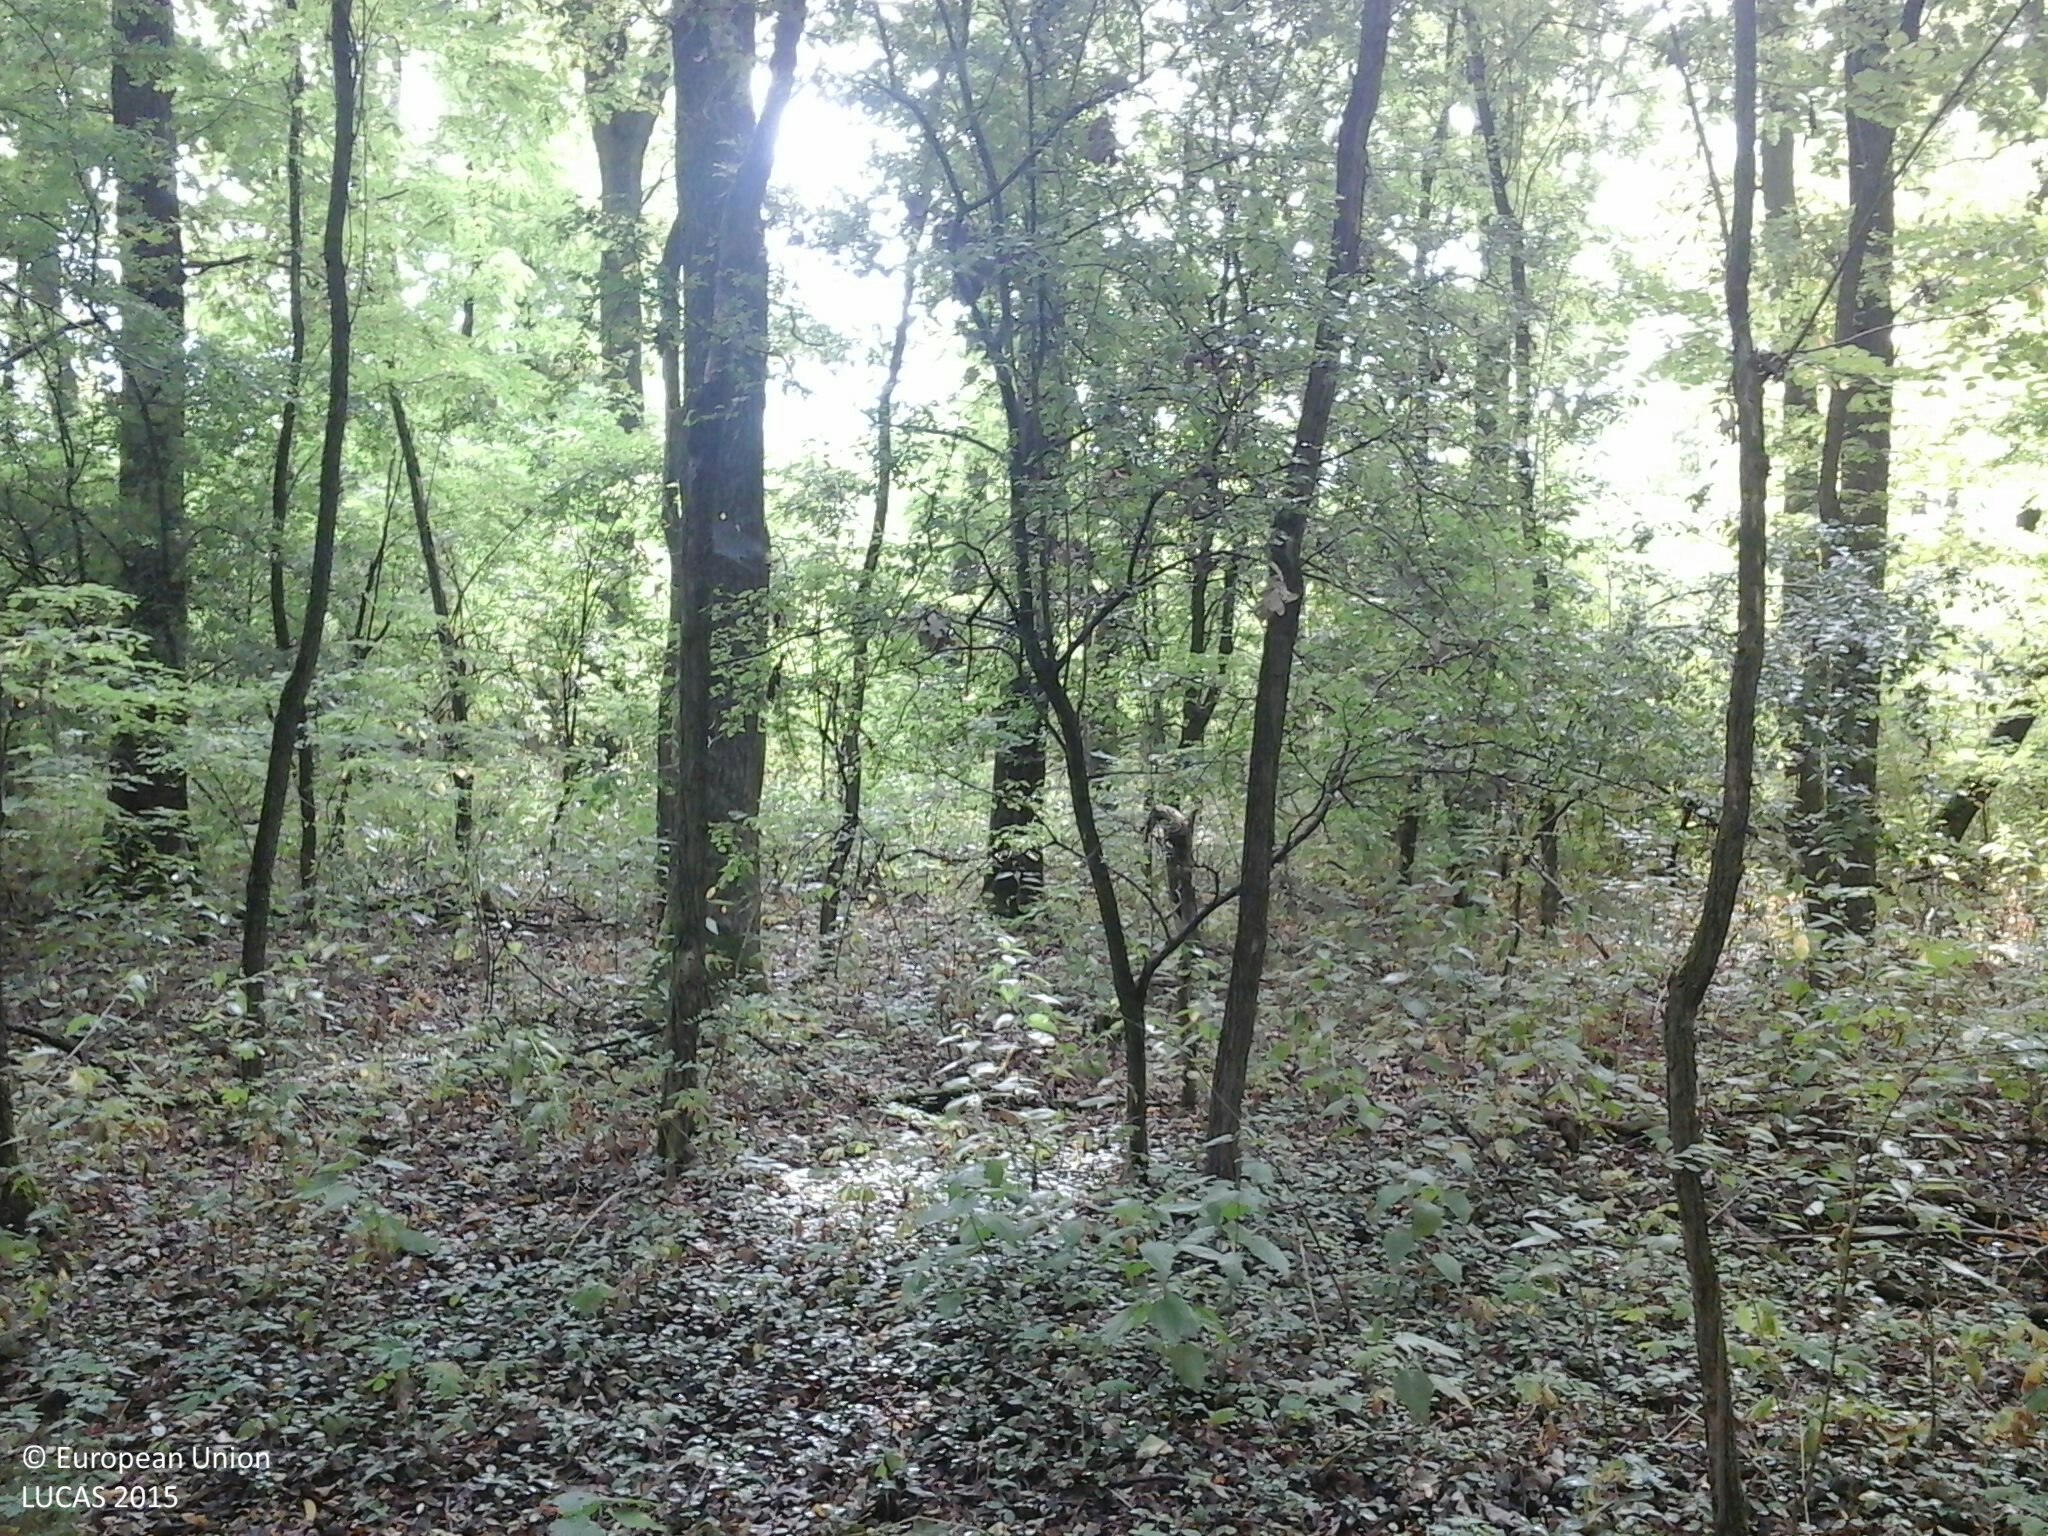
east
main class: Woodland
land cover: Broadleaved woodland
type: mesophytic deciduous forest
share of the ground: > 75 %
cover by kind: broadleaved forest trees 95 %, herbaceous plants 5 %
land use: Forestry
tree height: > 5 m
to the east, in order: Broadleaved woodland; Tracks; Broadleaved woodland; Triticale
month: July
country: HU
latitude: 47.9199
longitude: 22.0832
